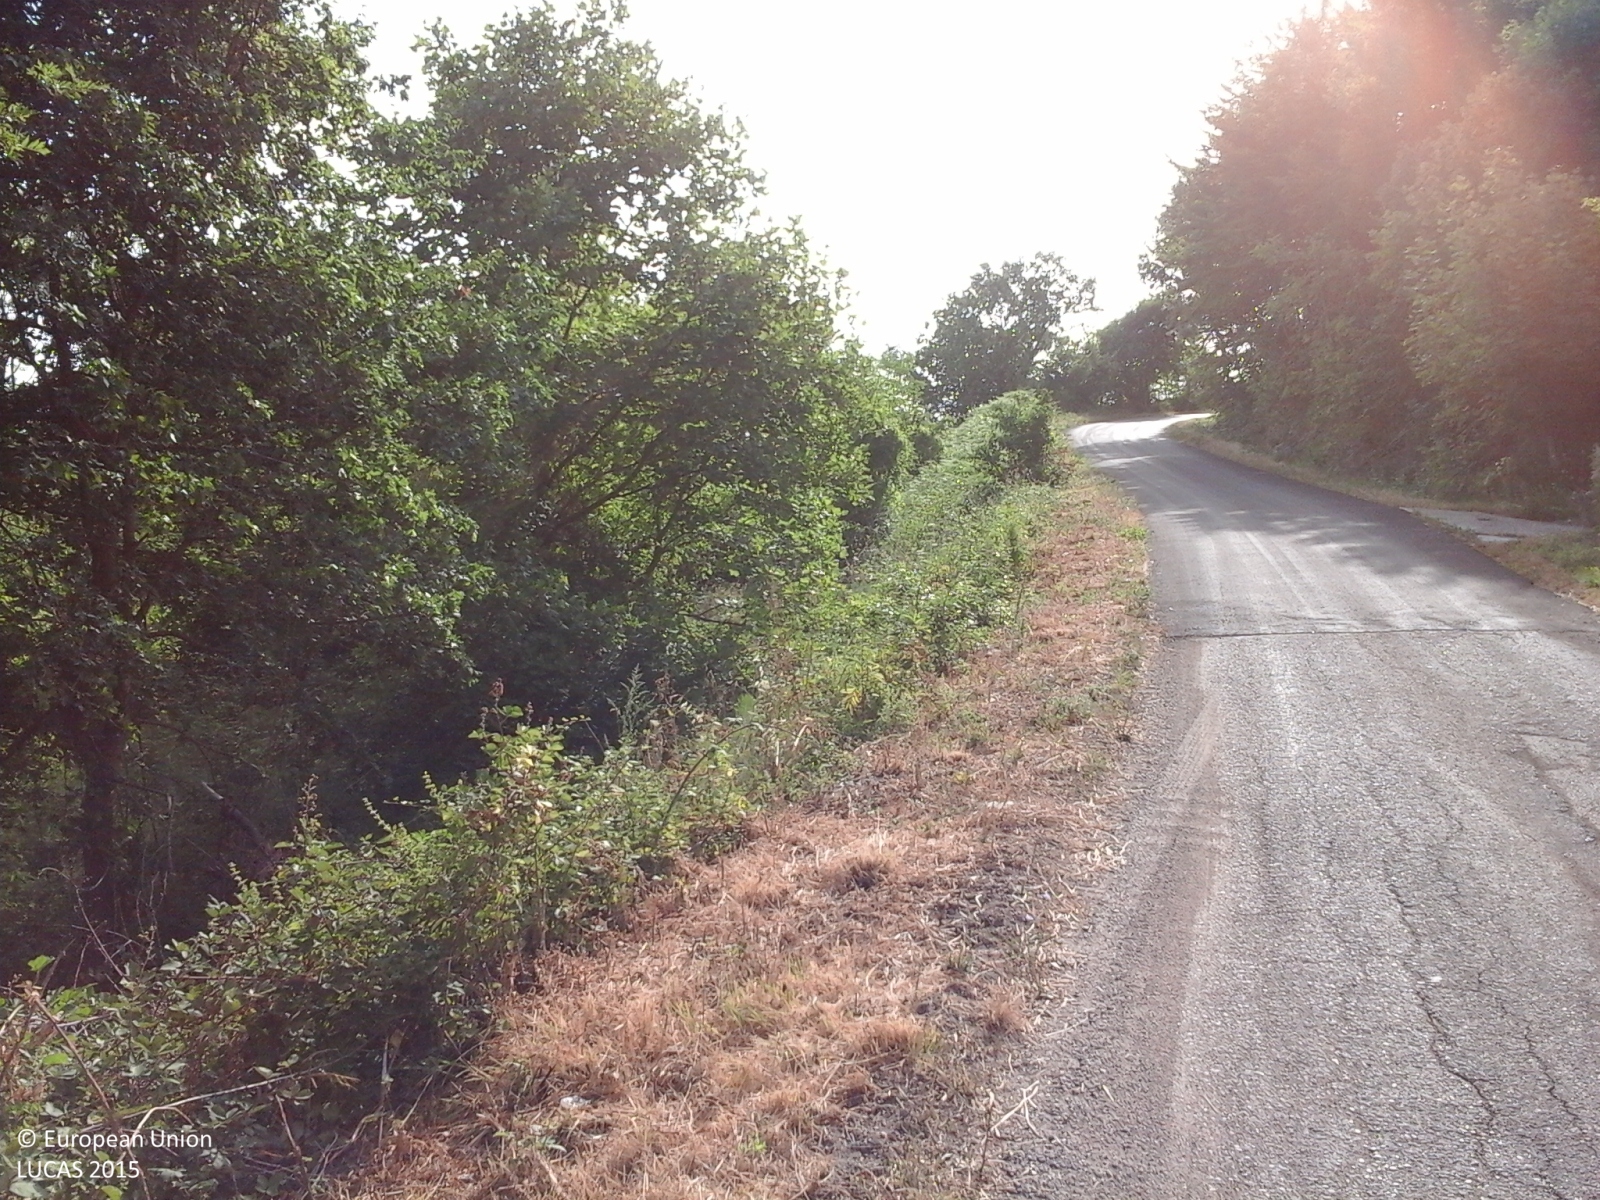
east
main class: Woodland
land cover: Broadleaved woodland
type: thermophilous deciduous forest
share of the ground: > 75 %
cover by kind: broadleaved forest trees 90 %, shrubs 5 %, herbaceous plants 5 %
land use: Forestry
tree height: > 5 m
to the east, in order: Broadleaved woodland
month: July
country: IT
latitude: 41.8396
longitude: 14.6934
